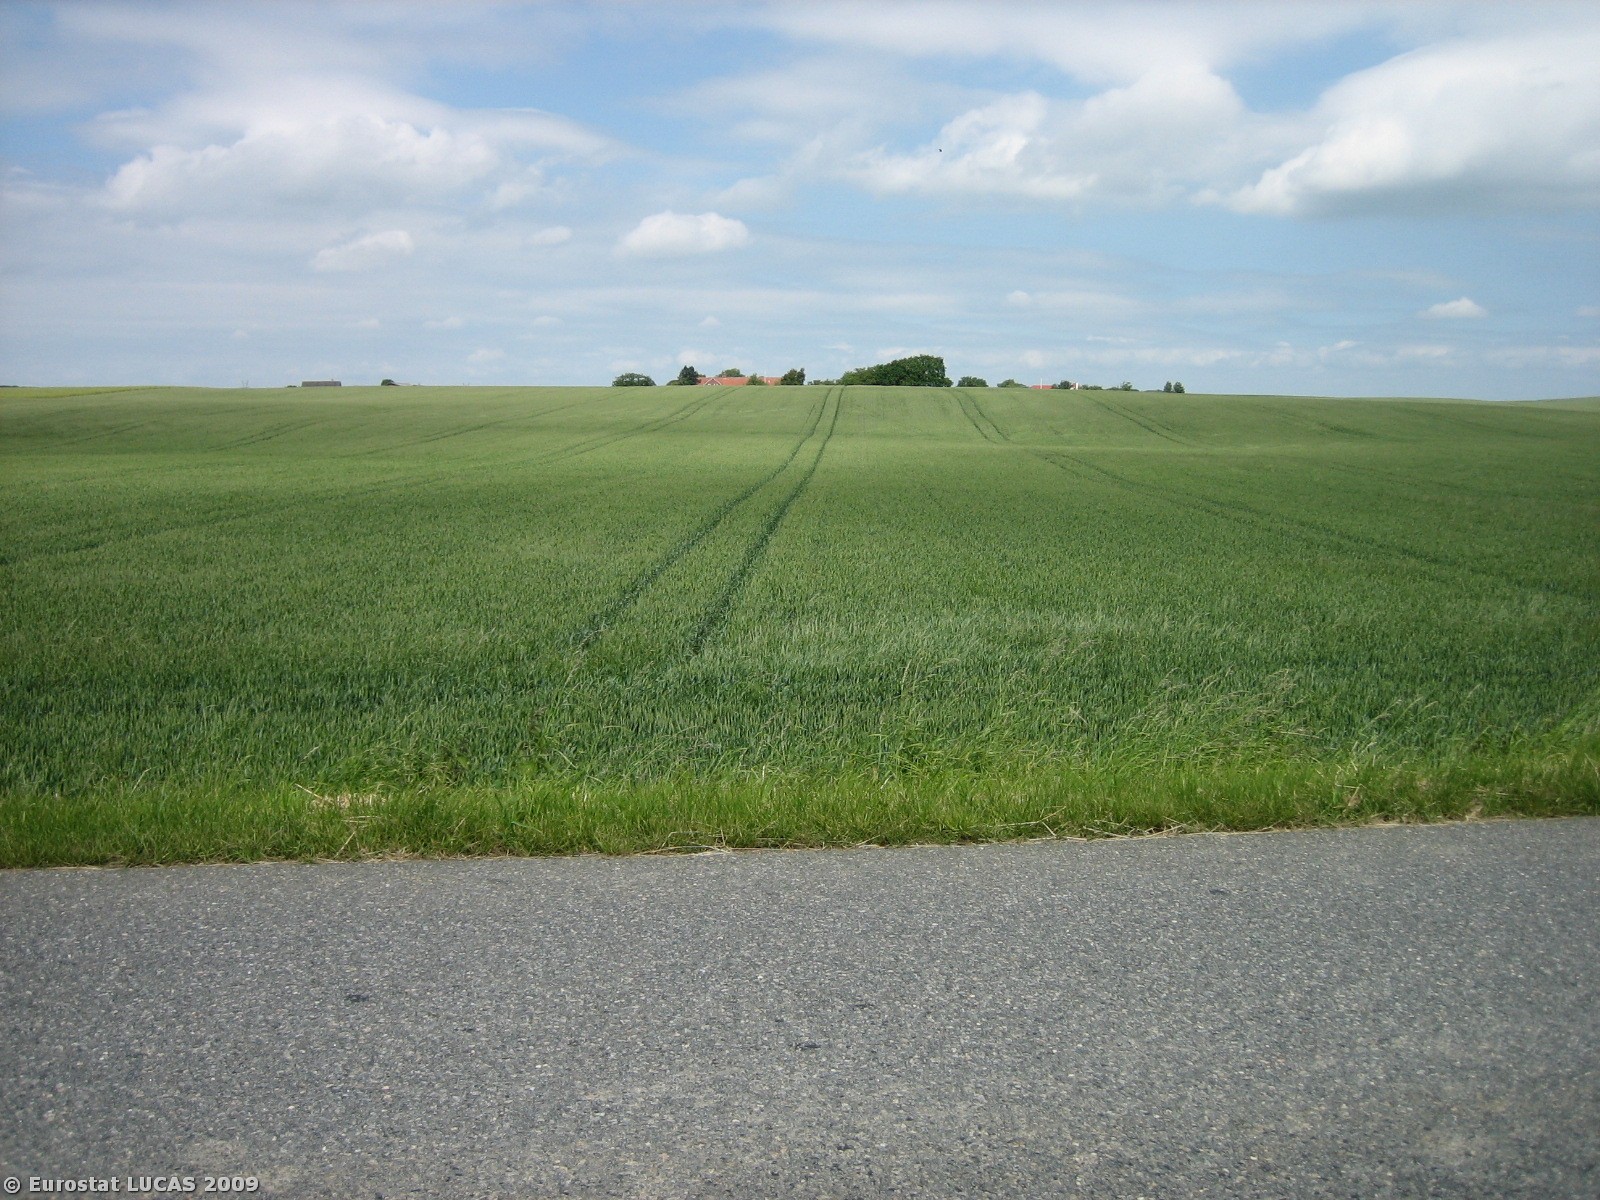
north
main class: Cropland
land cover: Common wheat
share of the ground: > 75 %
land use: Agriculture (excluding fallow land and kitchen gardens)
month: June
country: DK
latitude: 55.9181
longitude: 9.9840
